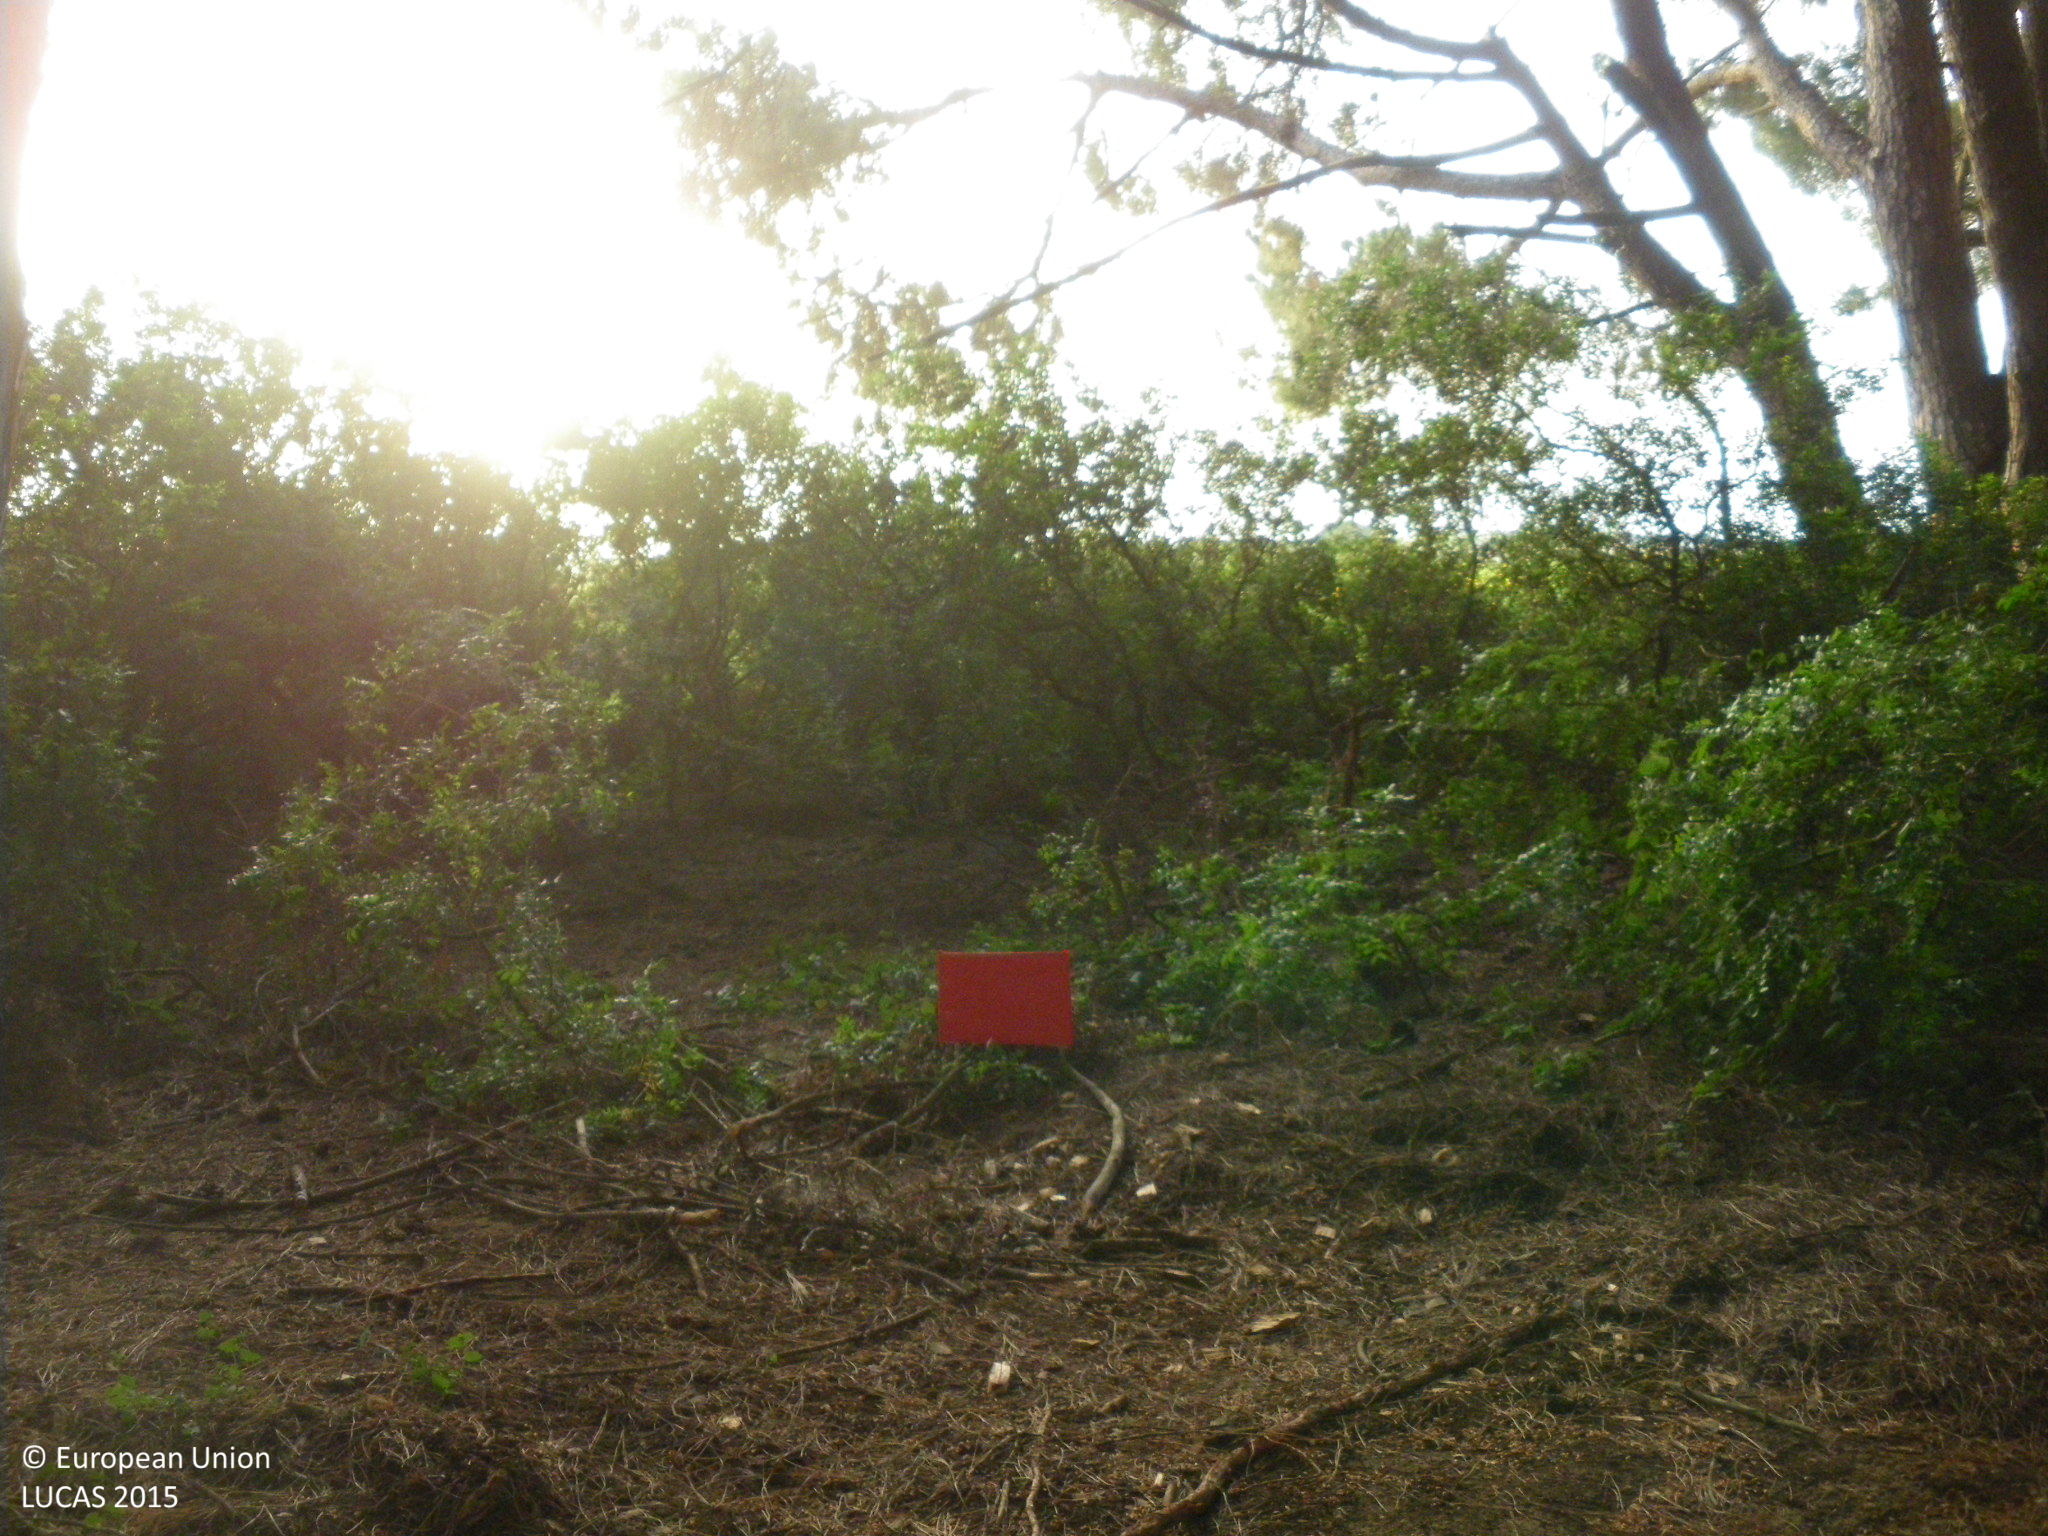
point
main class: Woodland
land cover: Pine dominated coniferous woodland
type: coniferous forest of the mediterranean region
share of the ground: > 75 %
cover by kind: coniferous forest trees 100 %
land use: Forestry
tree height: > 5 m
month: June
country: ES
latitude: 36.5492
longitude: -6.1070
